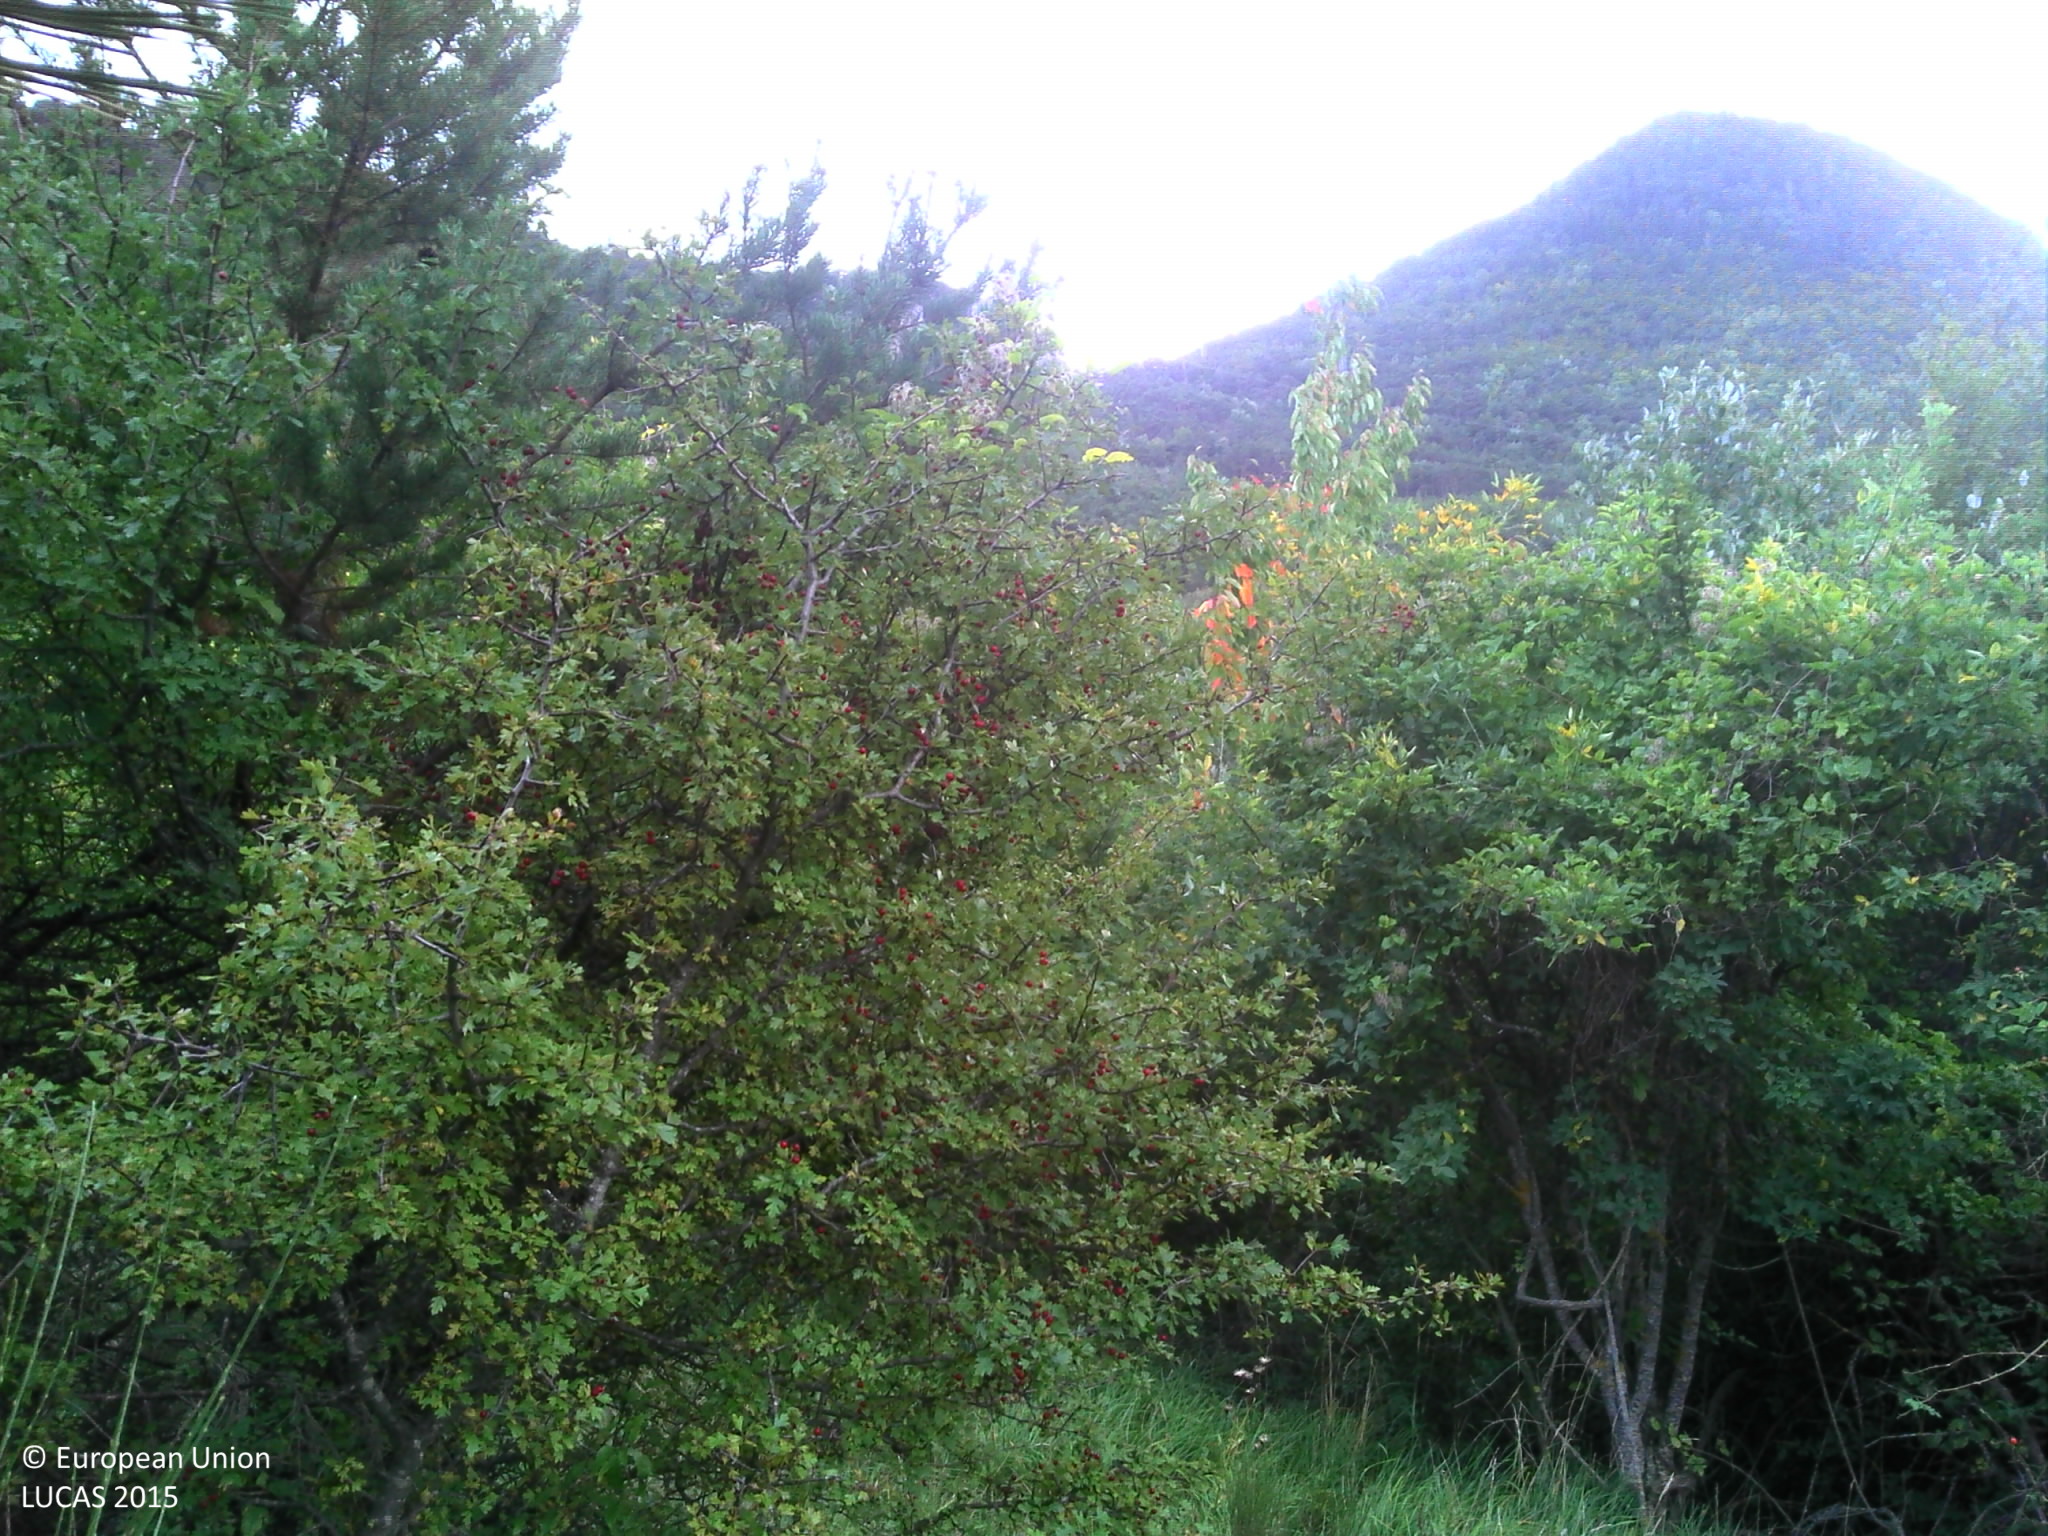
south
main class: Woodland
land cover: Pine dominated coniferous woodland
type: alpine coniferous forest
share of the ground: > 75 %
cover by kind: coniferous forest trees 75 %, shrubs 10 %, broadleaved forest trees 5 %, herbaceous plants 5 %, consolidated bare surface 5 %
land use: Forestry
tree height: > 5 m
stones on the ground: < 10 %
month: September
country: FR
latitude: 44.4367
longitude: 5.5723
